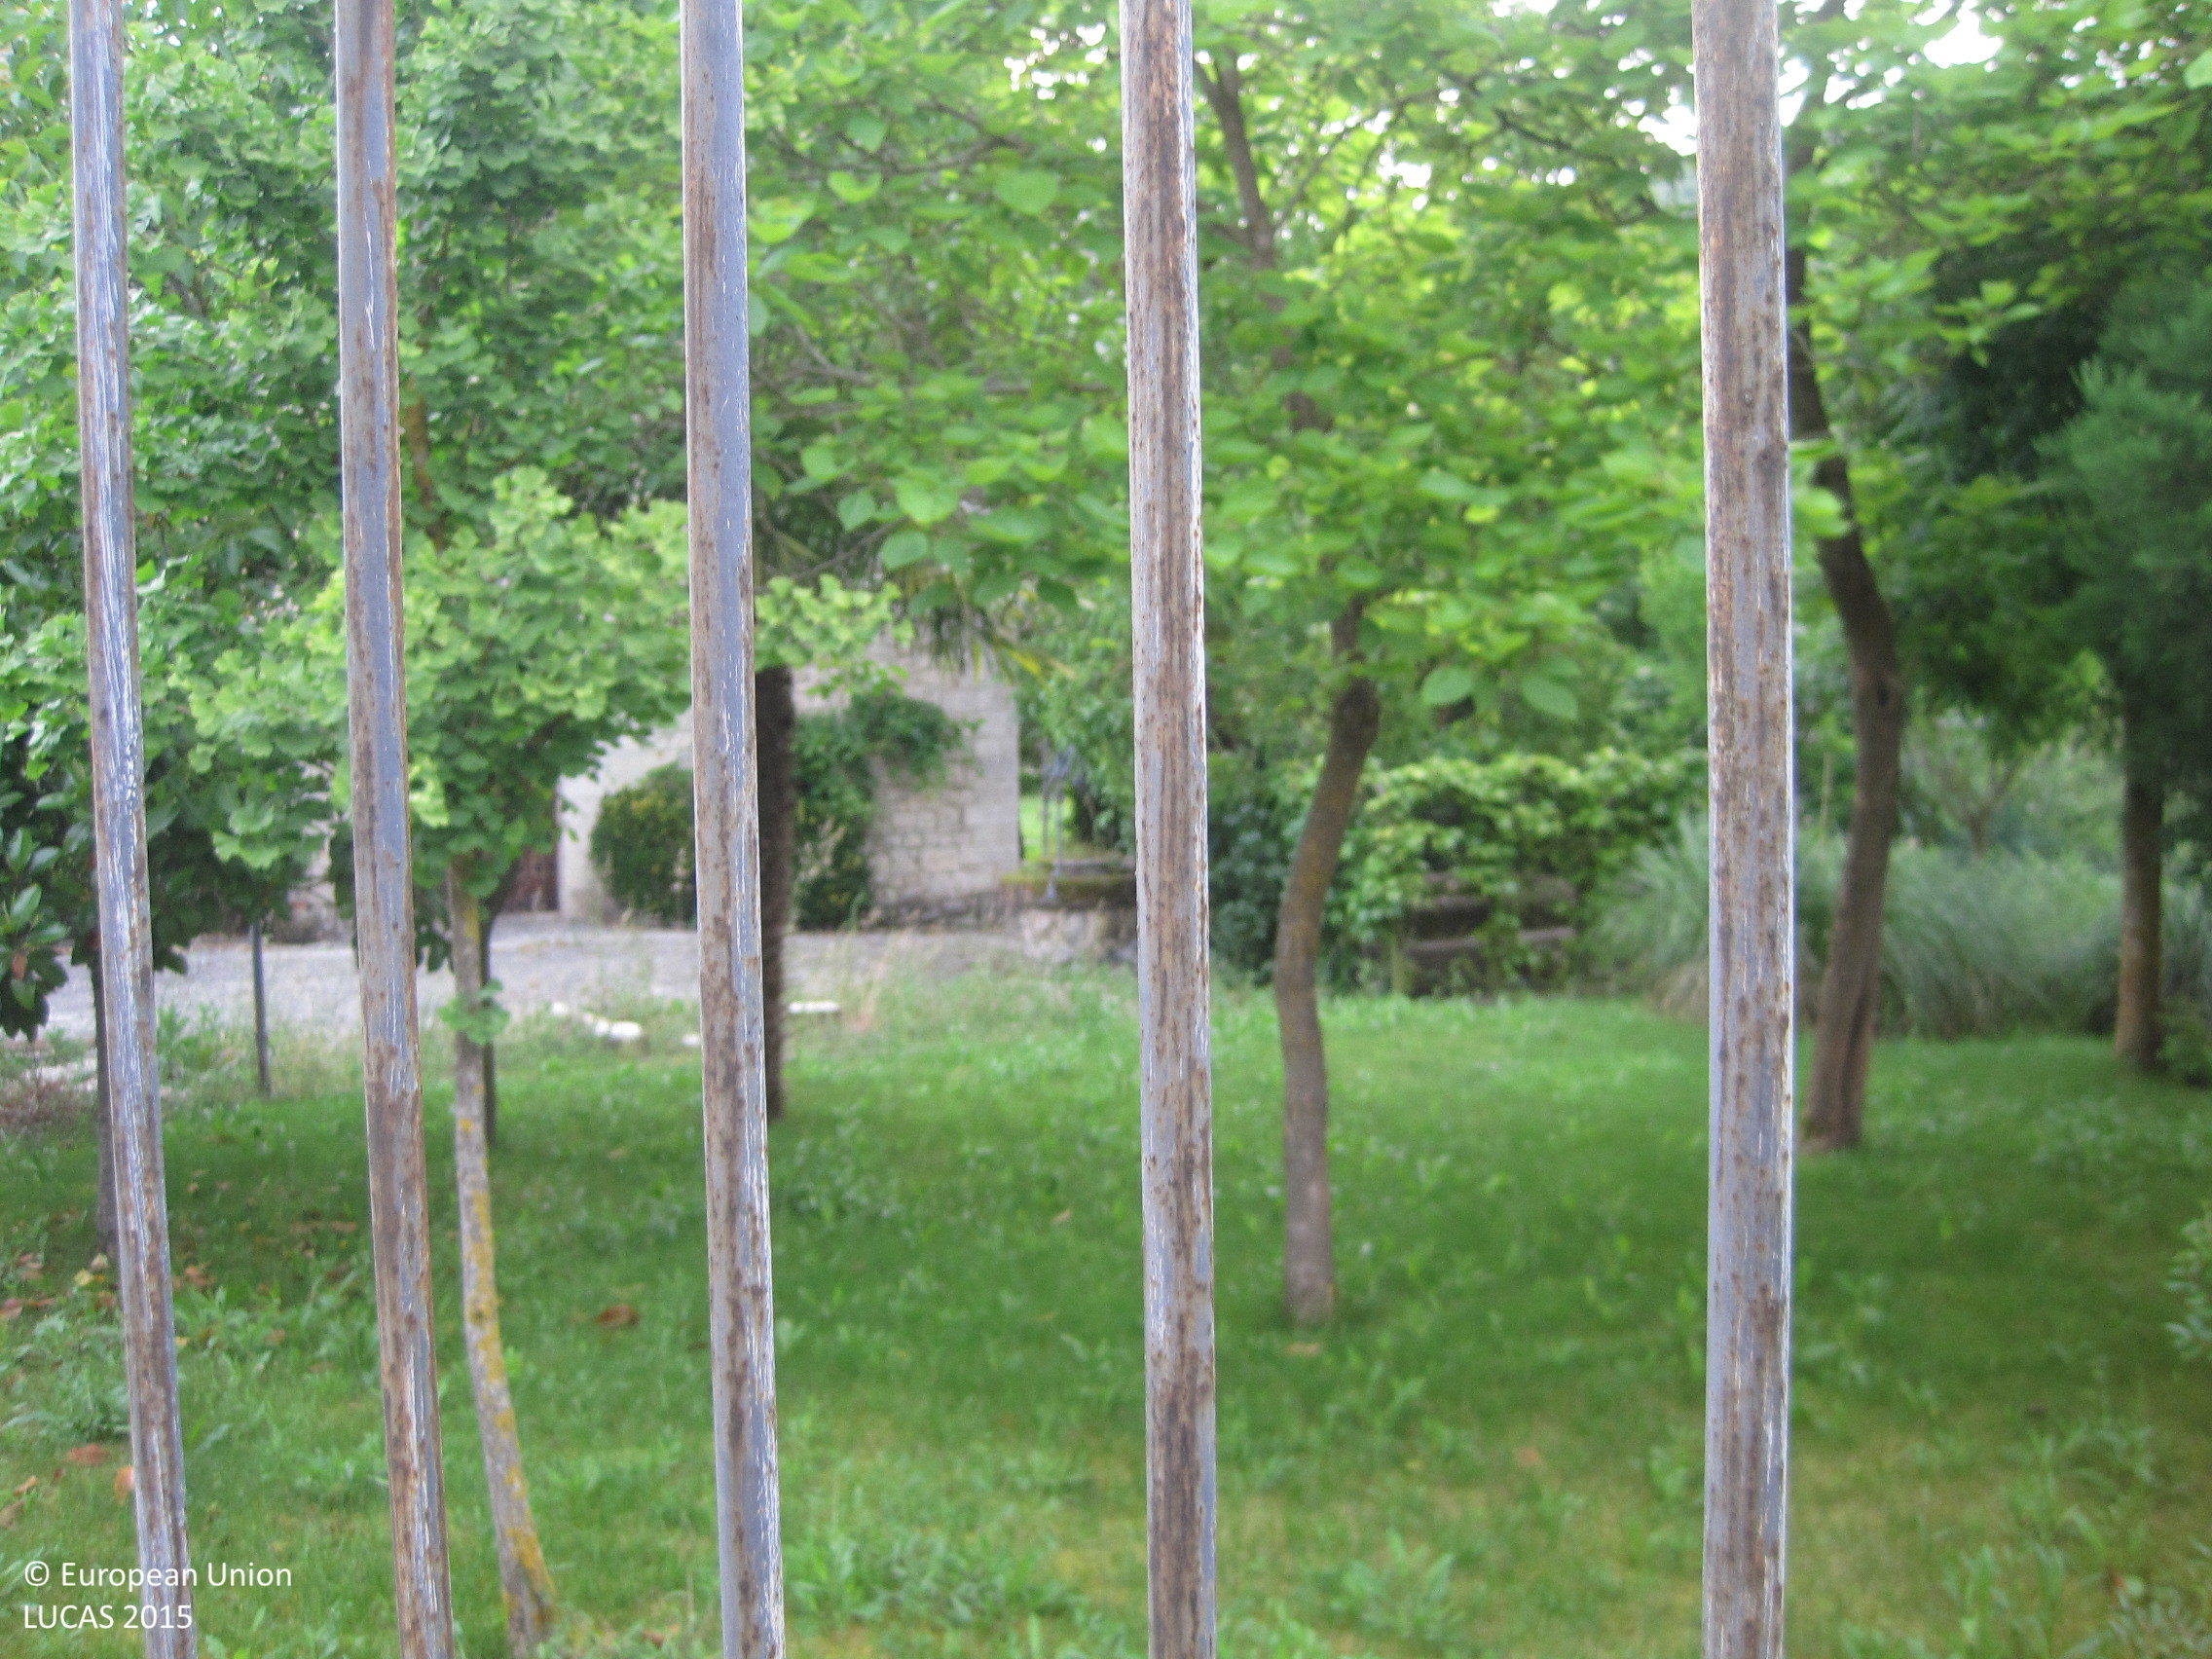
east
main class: Woodland
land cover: Broadleaved woodland
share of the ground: > 75 %
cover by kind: broadleaved forest trees 60 %, herbaceous plants 40 %
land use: Residential
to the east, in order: Broadleaved woodland; Artificial constructions in urban areas; Broadleaved woodland; Grassland without tree/shrub cover; Paved roads, cycling and walking lanes; Grass margins; Broadleaved woodland; Grassland without tree/shrub cover; Fences; Grassland without tree/shrub cover; Fences; Grassland without tree/shrub cover; Electric lines; Grassland without tree/shrub cover; Broadleaved woodland; Fences; Grassland without tree/shrub cover; Fences; Grassland with sparse tree/shrub cover
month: June
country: ES
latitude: 42.9222
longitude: -1.6915
